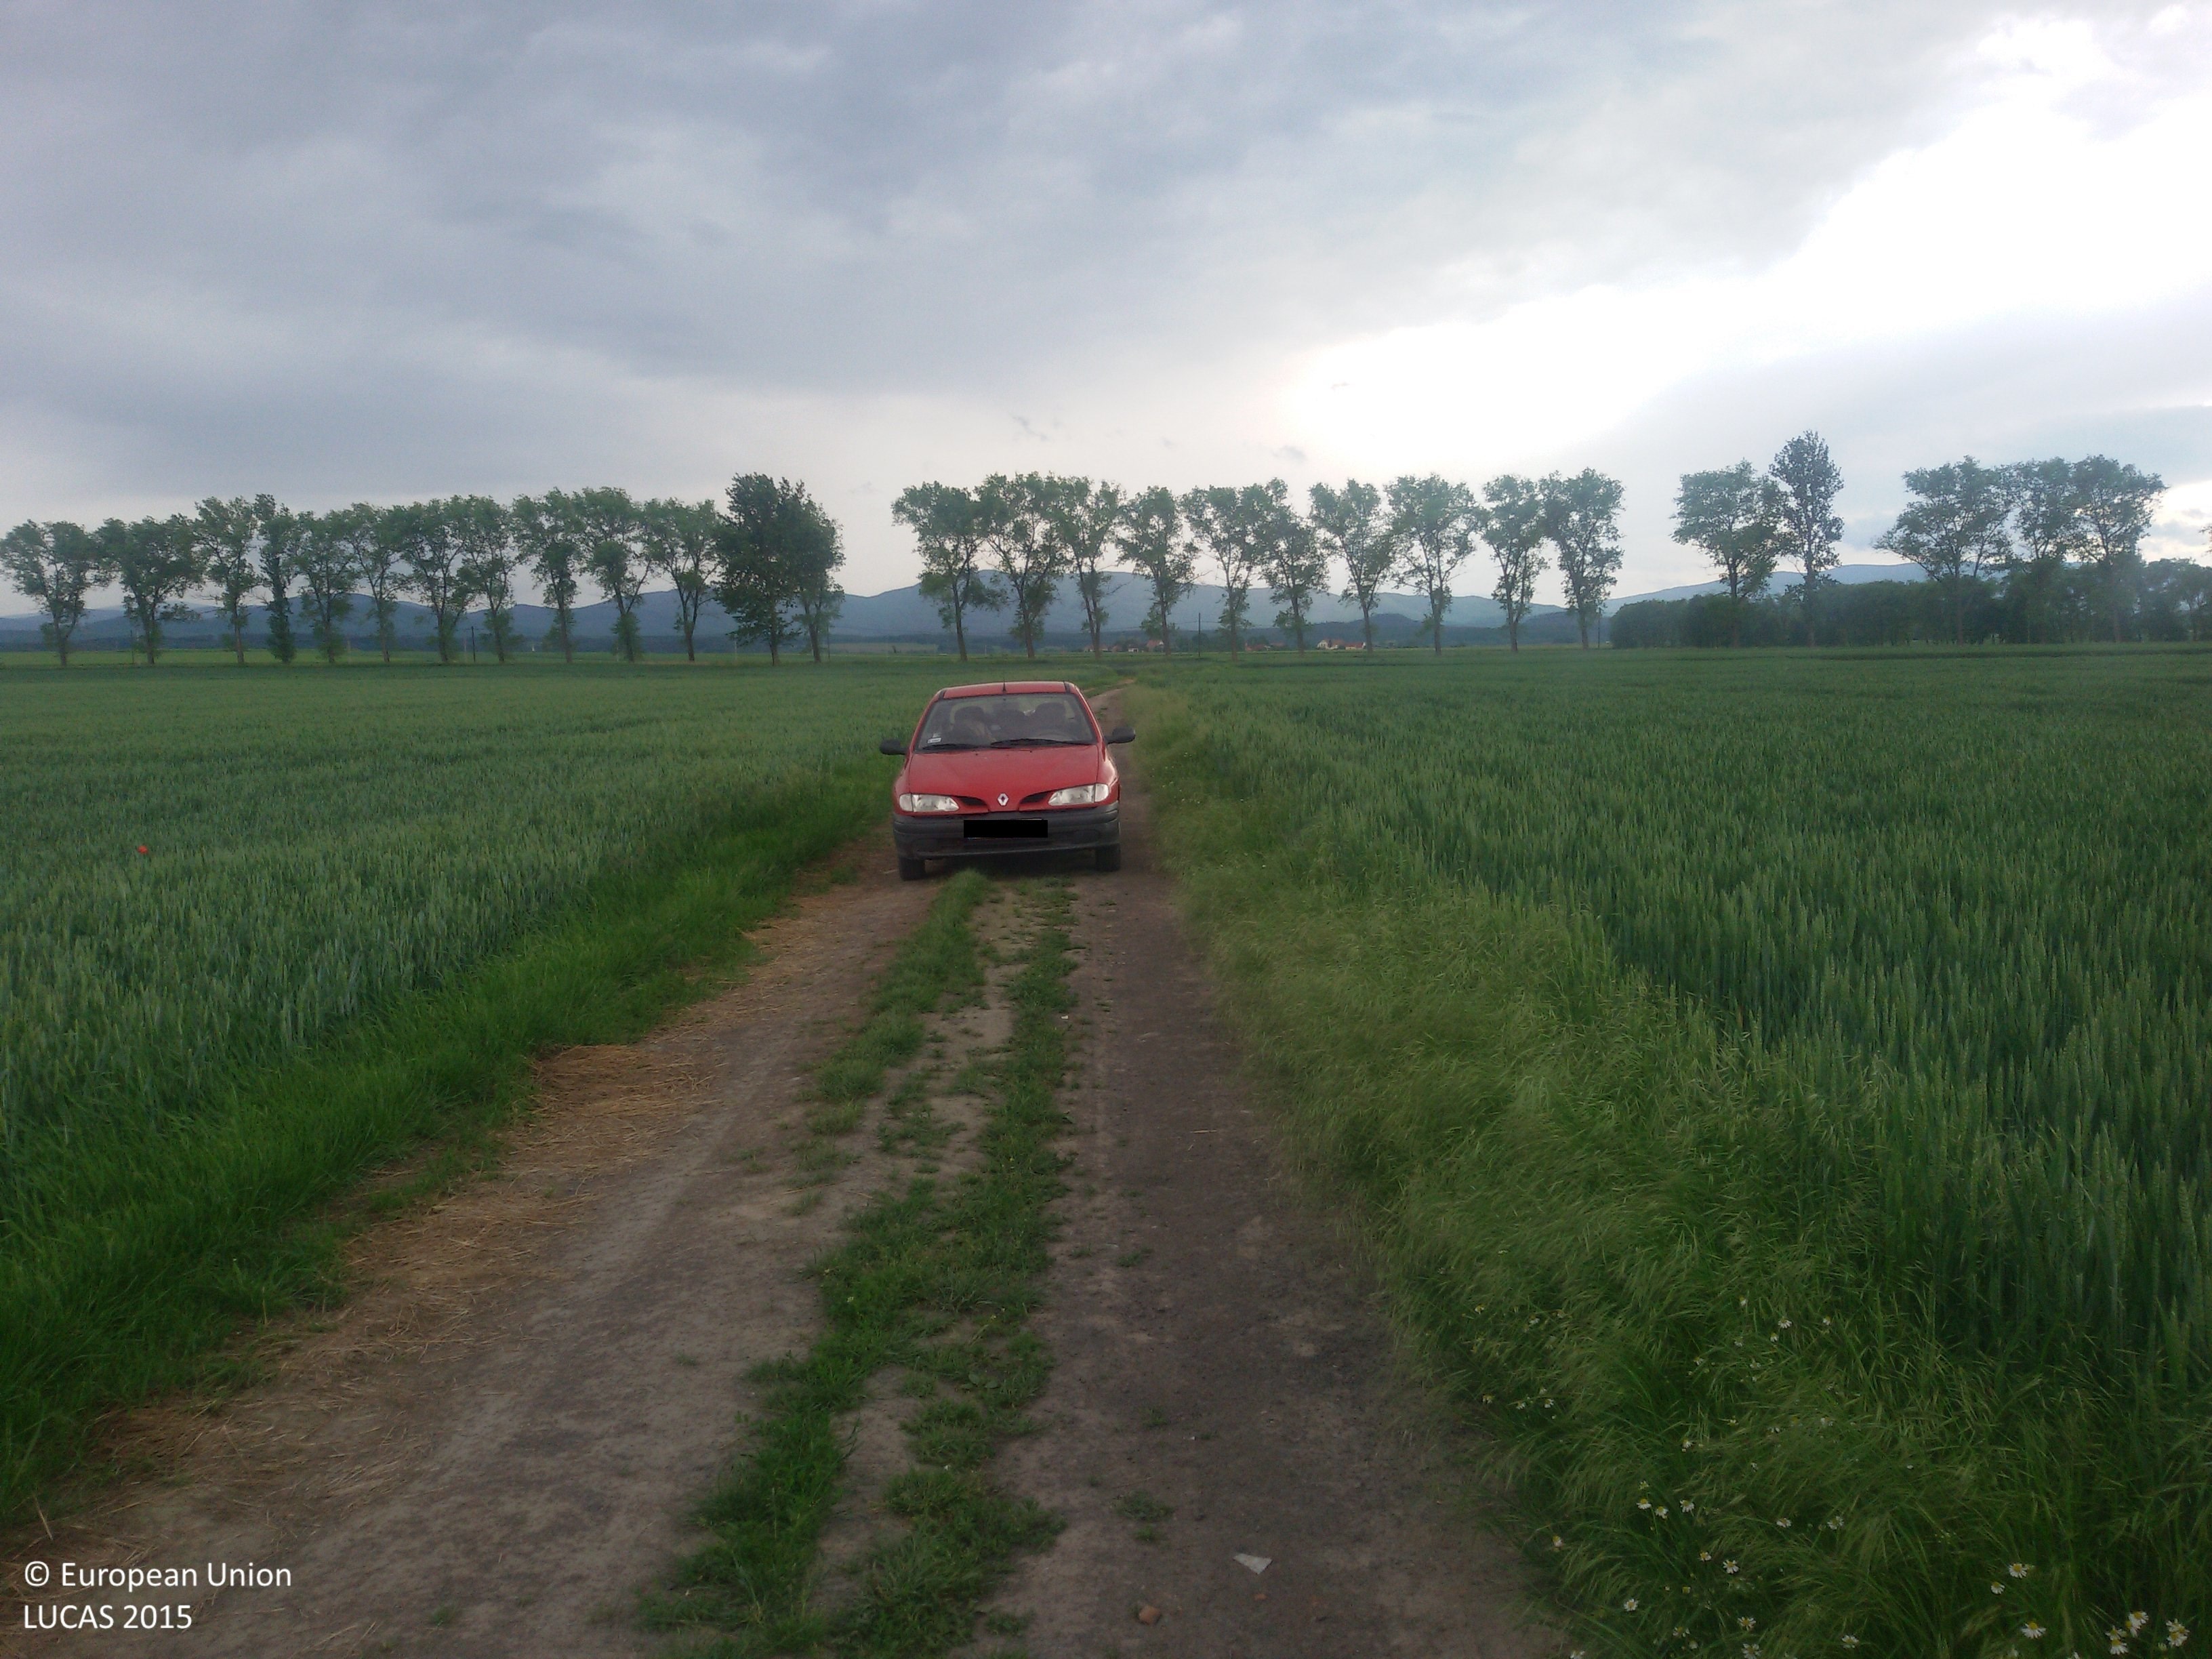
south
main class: Cropland
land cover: Common wheat
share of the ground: > 75 %
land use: Agriculture (excluding fallow land and kitchen gardens)
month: May
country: PL
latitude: 50.4095
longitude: 17.1732
